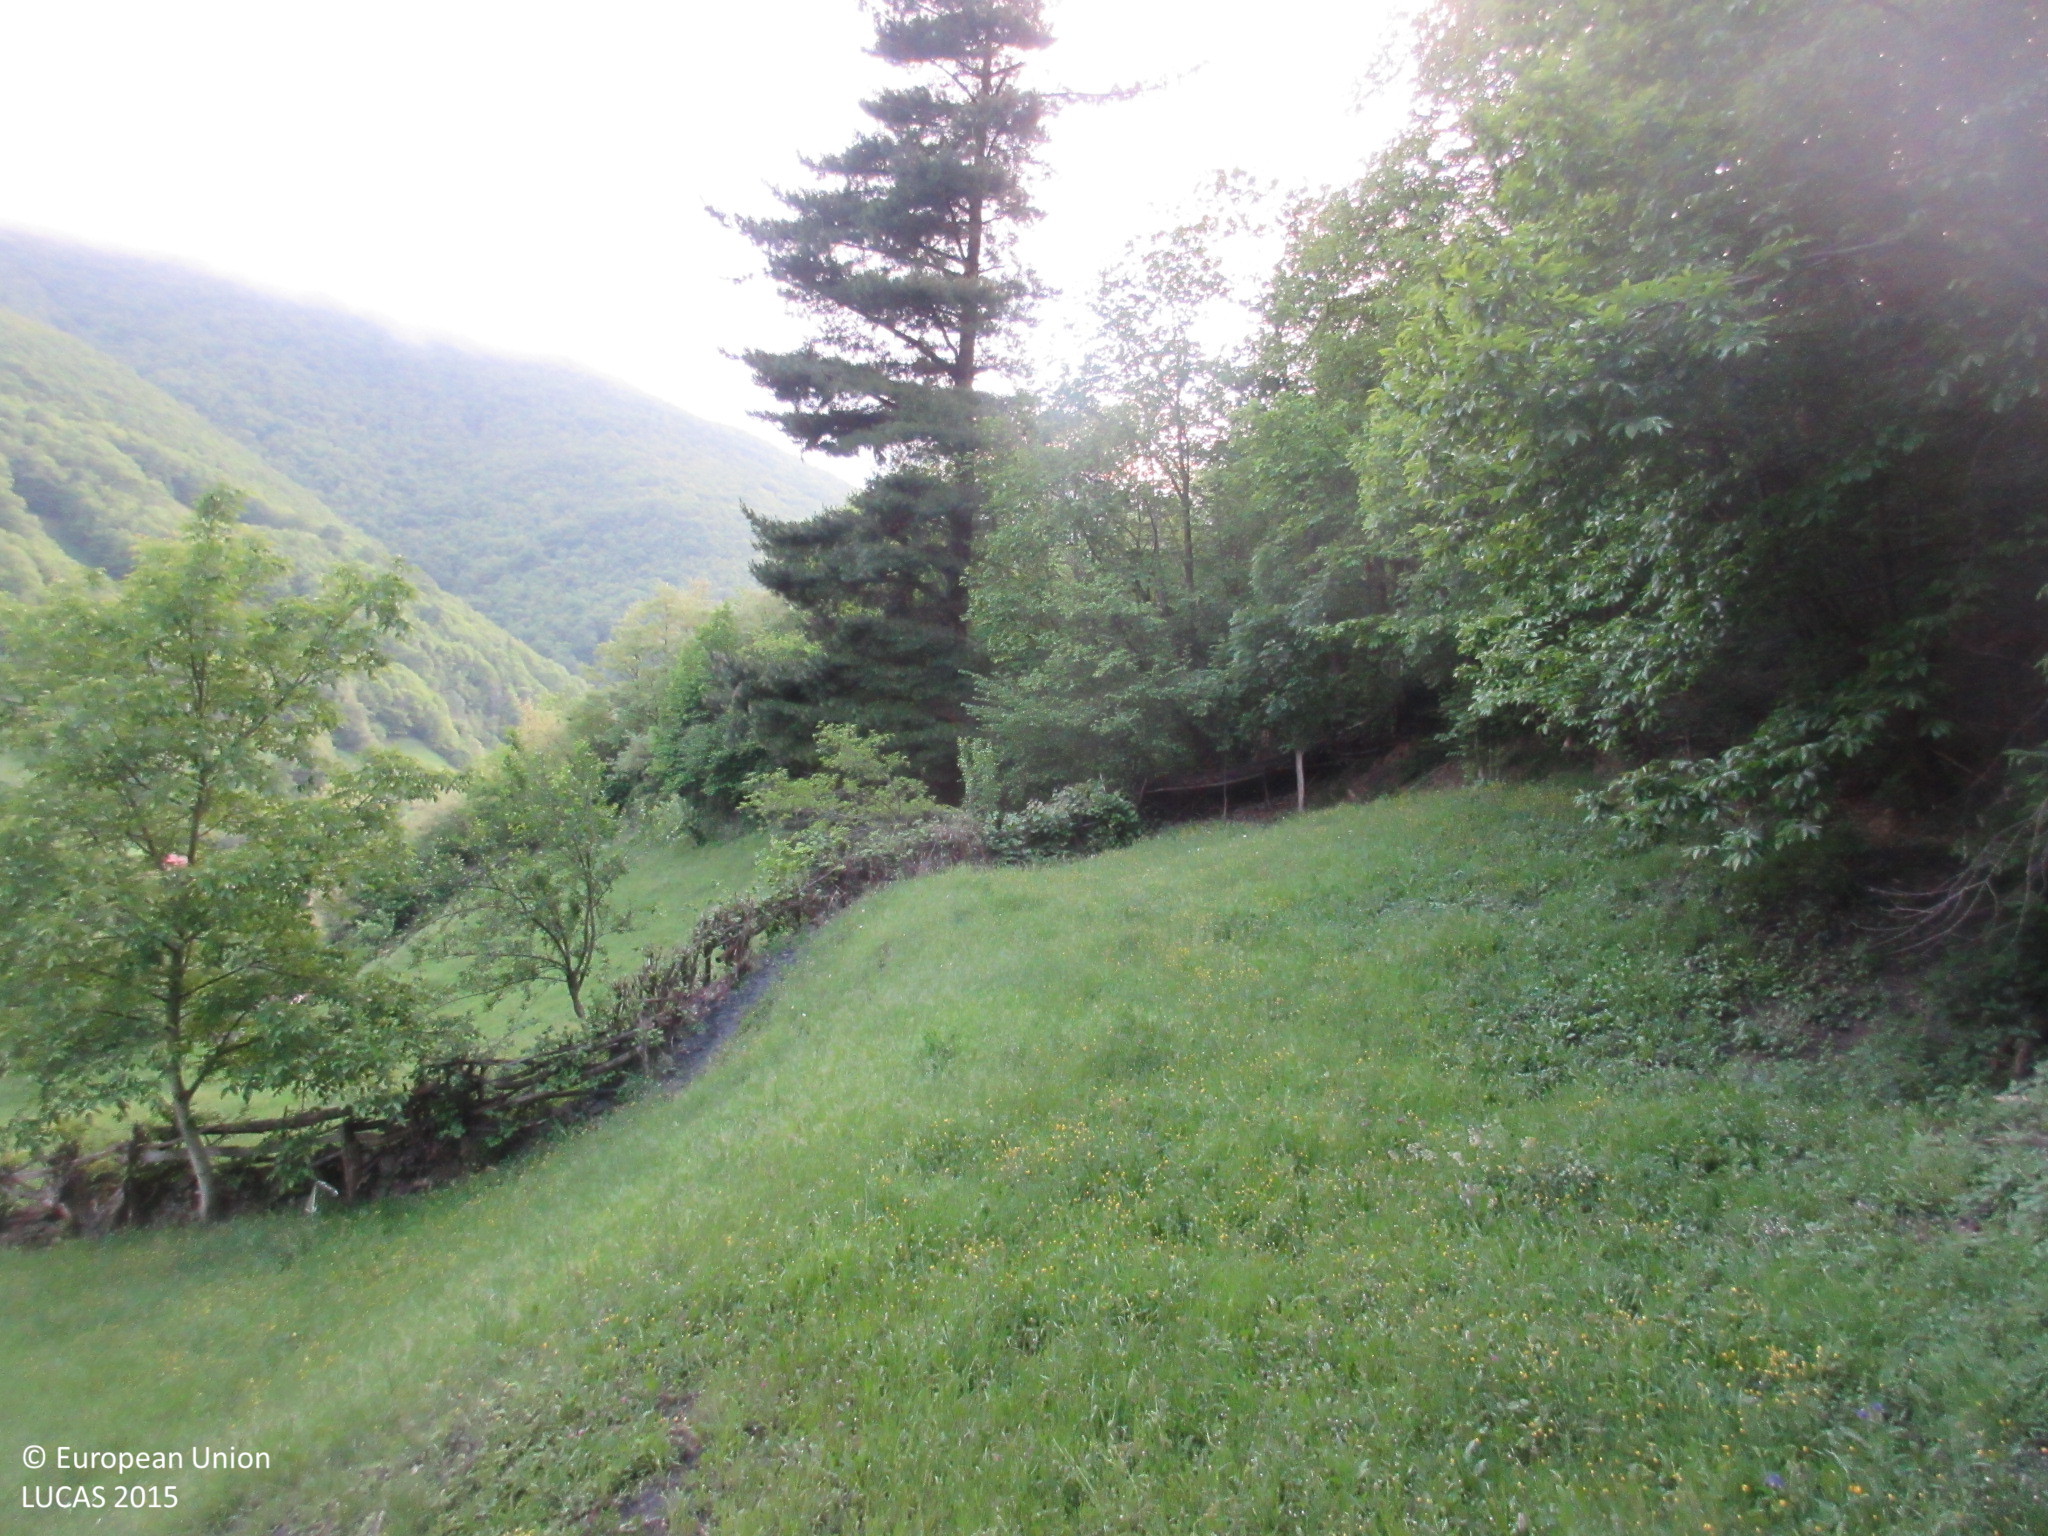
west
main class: Woodland
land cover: Broadleaved woodland
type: thermophilous deciduous forest
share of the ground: > 75 %
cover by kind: broadleaved forest trees 95 %, shrubs 5 %
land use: Semi-natural and natural areas not in use
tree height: > 5 m
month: May
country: ES
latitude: 43.1043
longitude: -5.4980
